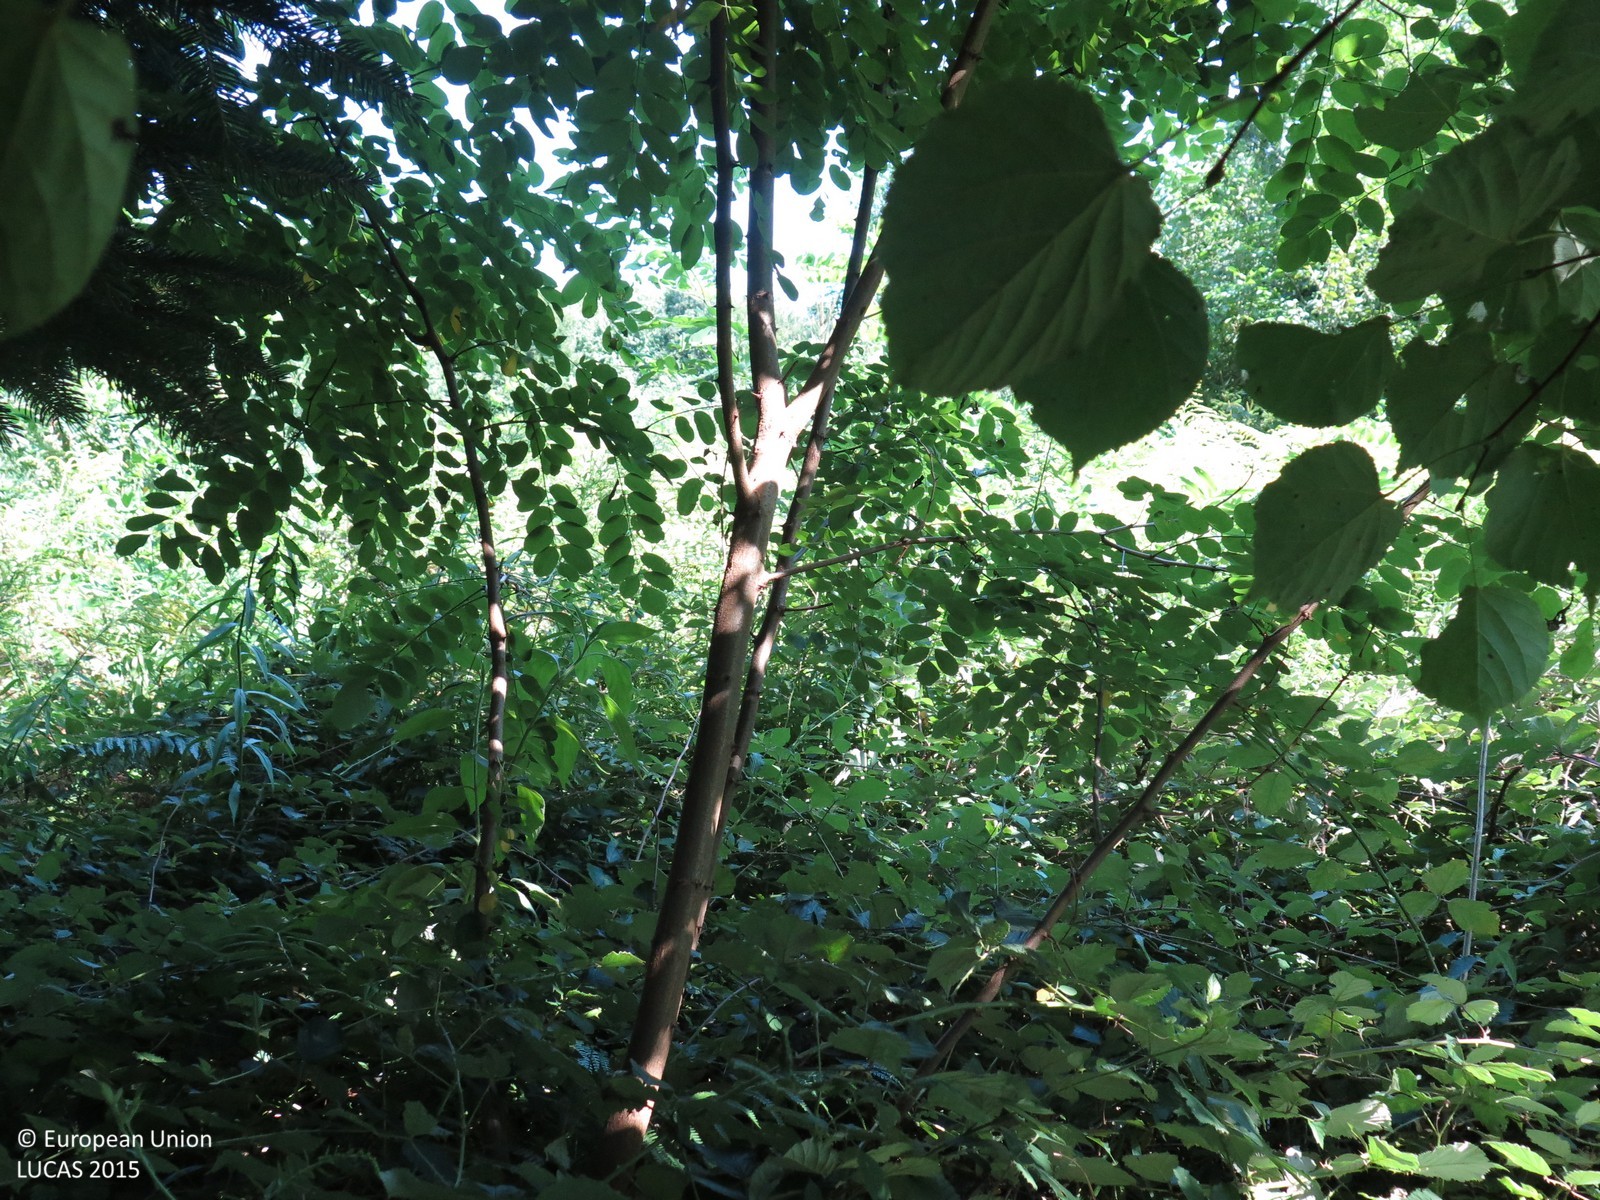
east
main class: Woodland
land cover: Other mixed woodland
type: mountainous beech forest
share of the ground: > 75 %
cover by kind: coniferous forest trees 75 %, broadleaved forest trees 25 %
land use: Forestry
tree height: > 5 m
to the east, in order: Other mixed woodland; Shrubland with sparse tree cover
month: August
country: HR
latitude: 45.3934
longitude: 15.2200
